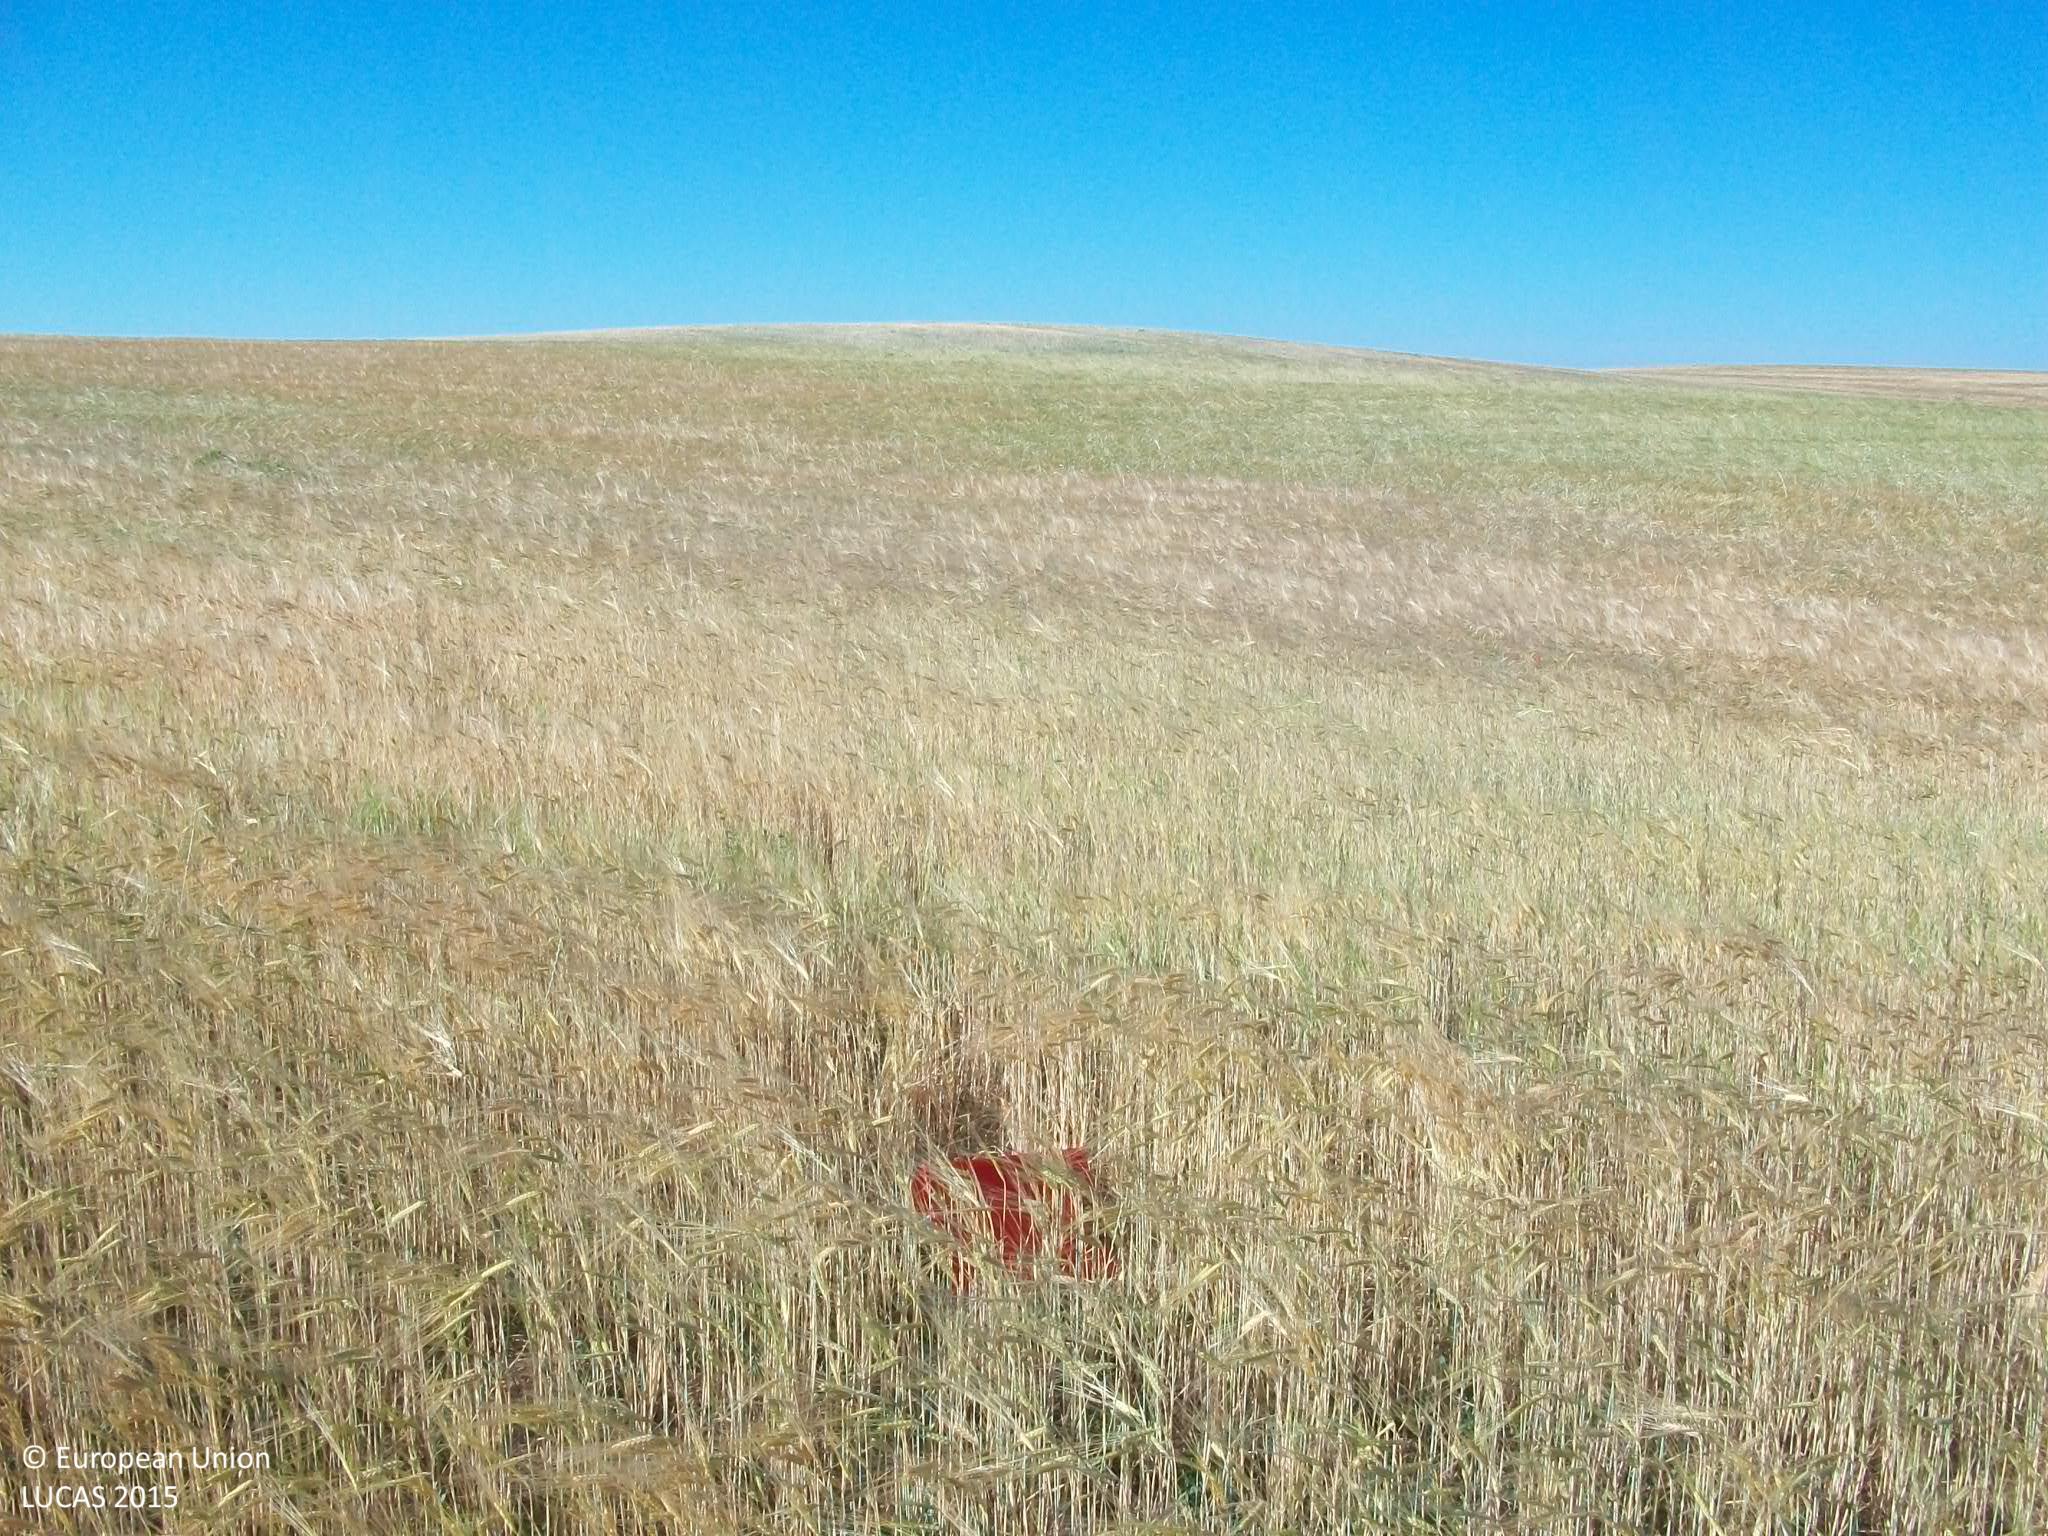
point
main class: Cropland
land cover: Barley
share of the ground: > 75 %
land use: Agriculture (excluding fallow land and kitchen gardens)
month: May
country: ES
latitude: 39.9020
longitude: -3.7277
